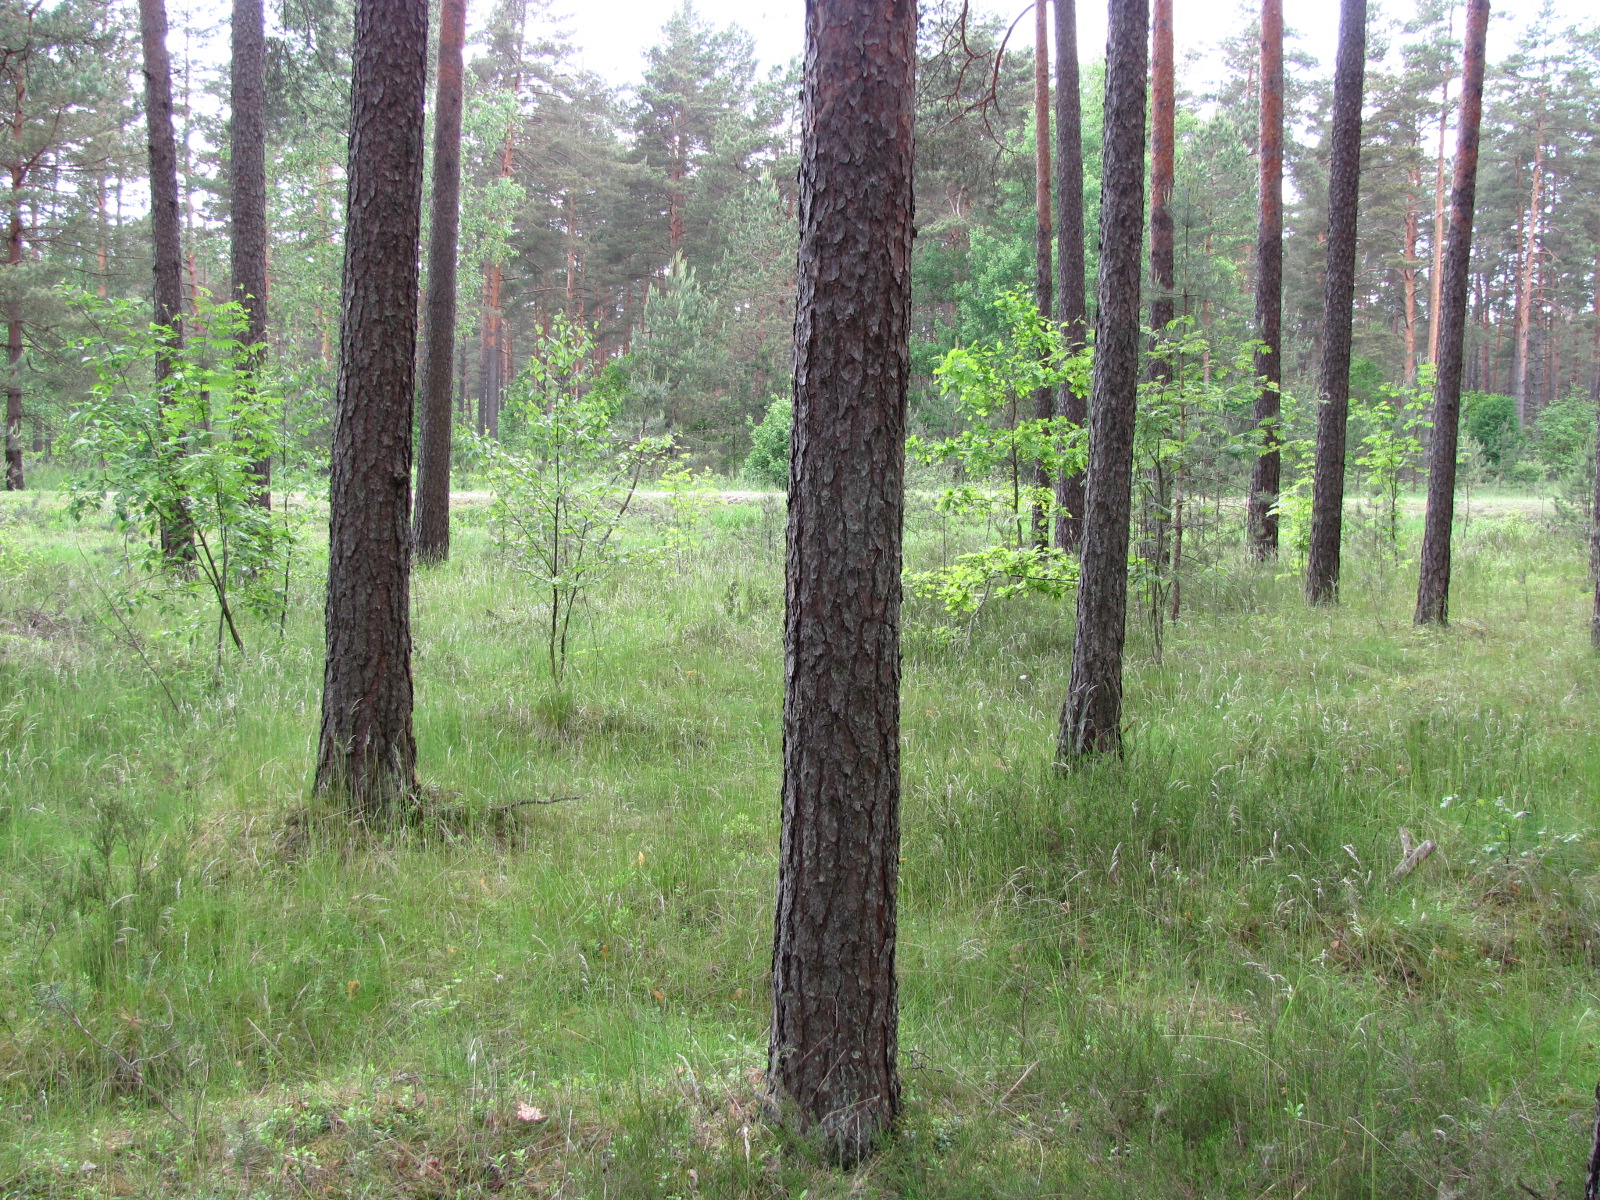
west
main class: Woodland
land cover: Pine dominated coniferous woodland
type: hemiboreal forest and nemoral coniferous forest and mixed broadleaved-coniferous forest
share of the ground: > 75 %
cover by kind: coniferous forest trees 85 %, lichens and mosses 10 %, herbaceous plants 5 %
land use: Forestry
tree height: > 5 m
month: June
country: LV
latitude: 56.9534
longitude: 24.3122
